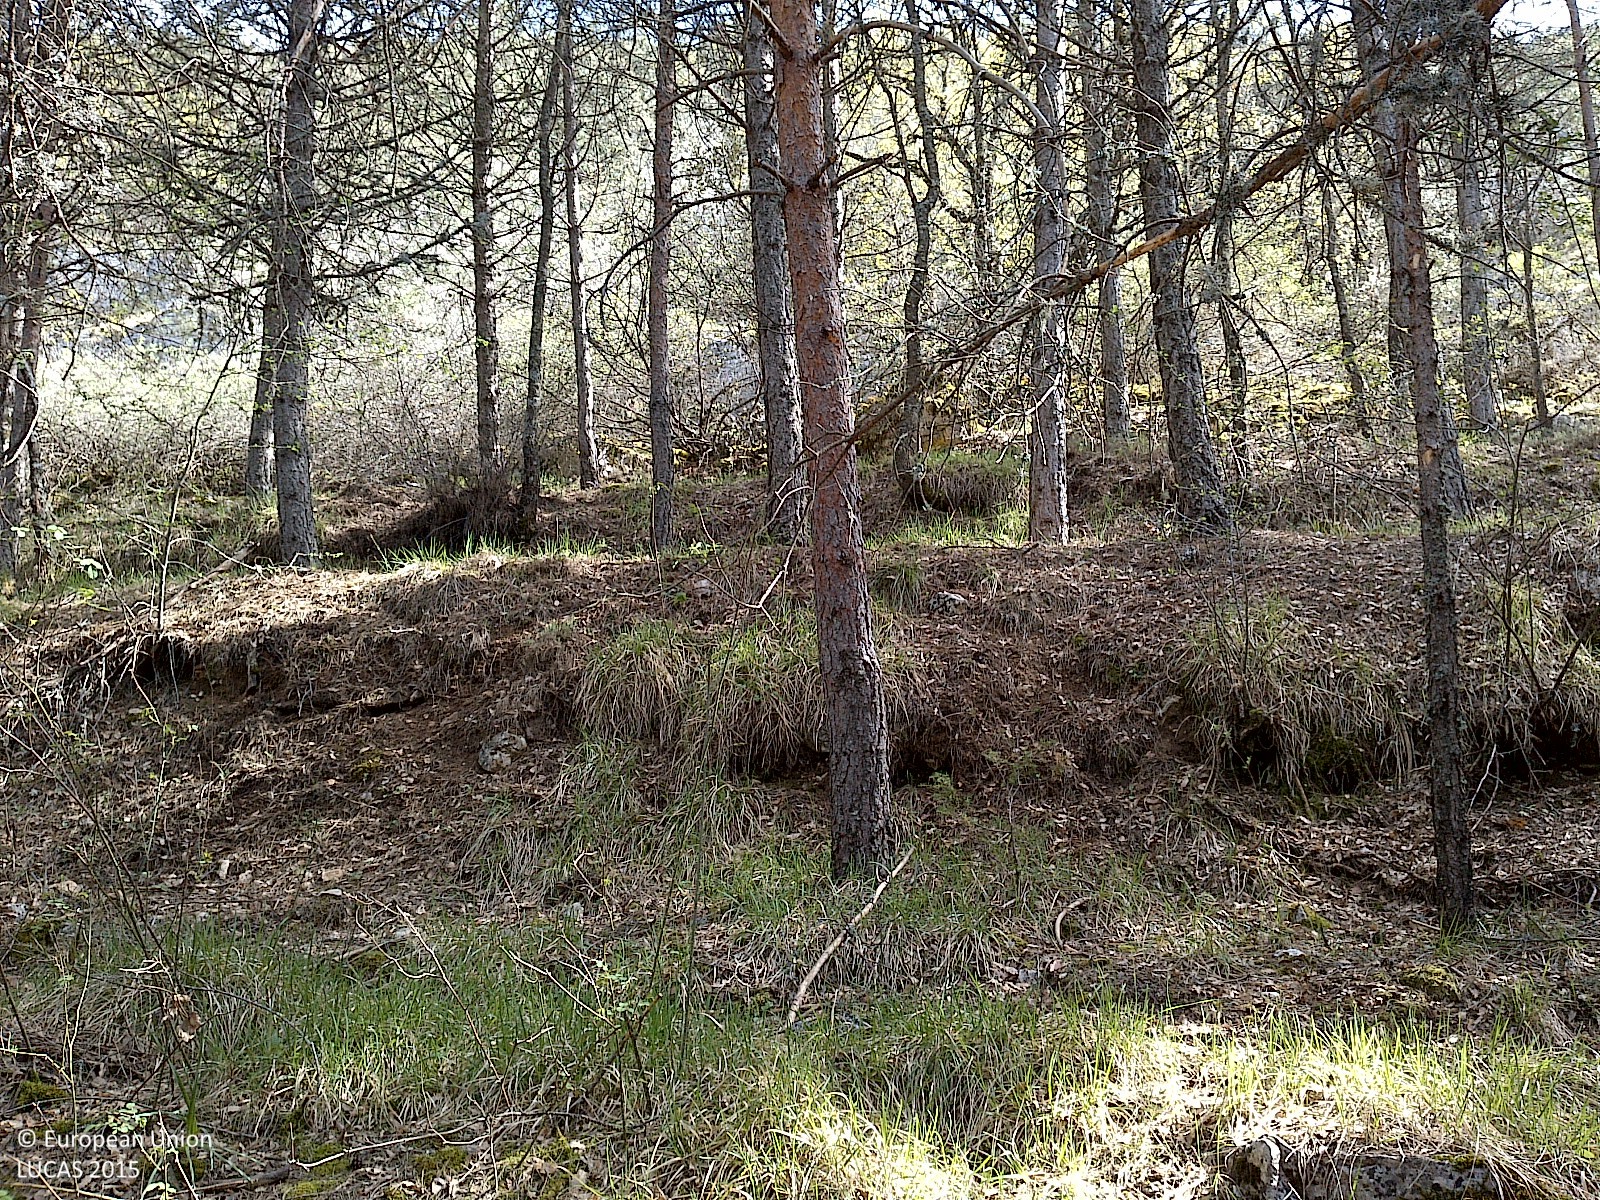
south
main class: Woodland
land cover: Pine dominated coniferous woodland
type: coniferous forest of the mediterranean region
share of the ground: > 75 %
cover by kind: coniferous forest trees 90 %, broadleaved forest trees 10 %
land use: Forestry
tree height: > 5 m
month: April
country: ES
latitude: 41.8299
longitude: -3.2817
